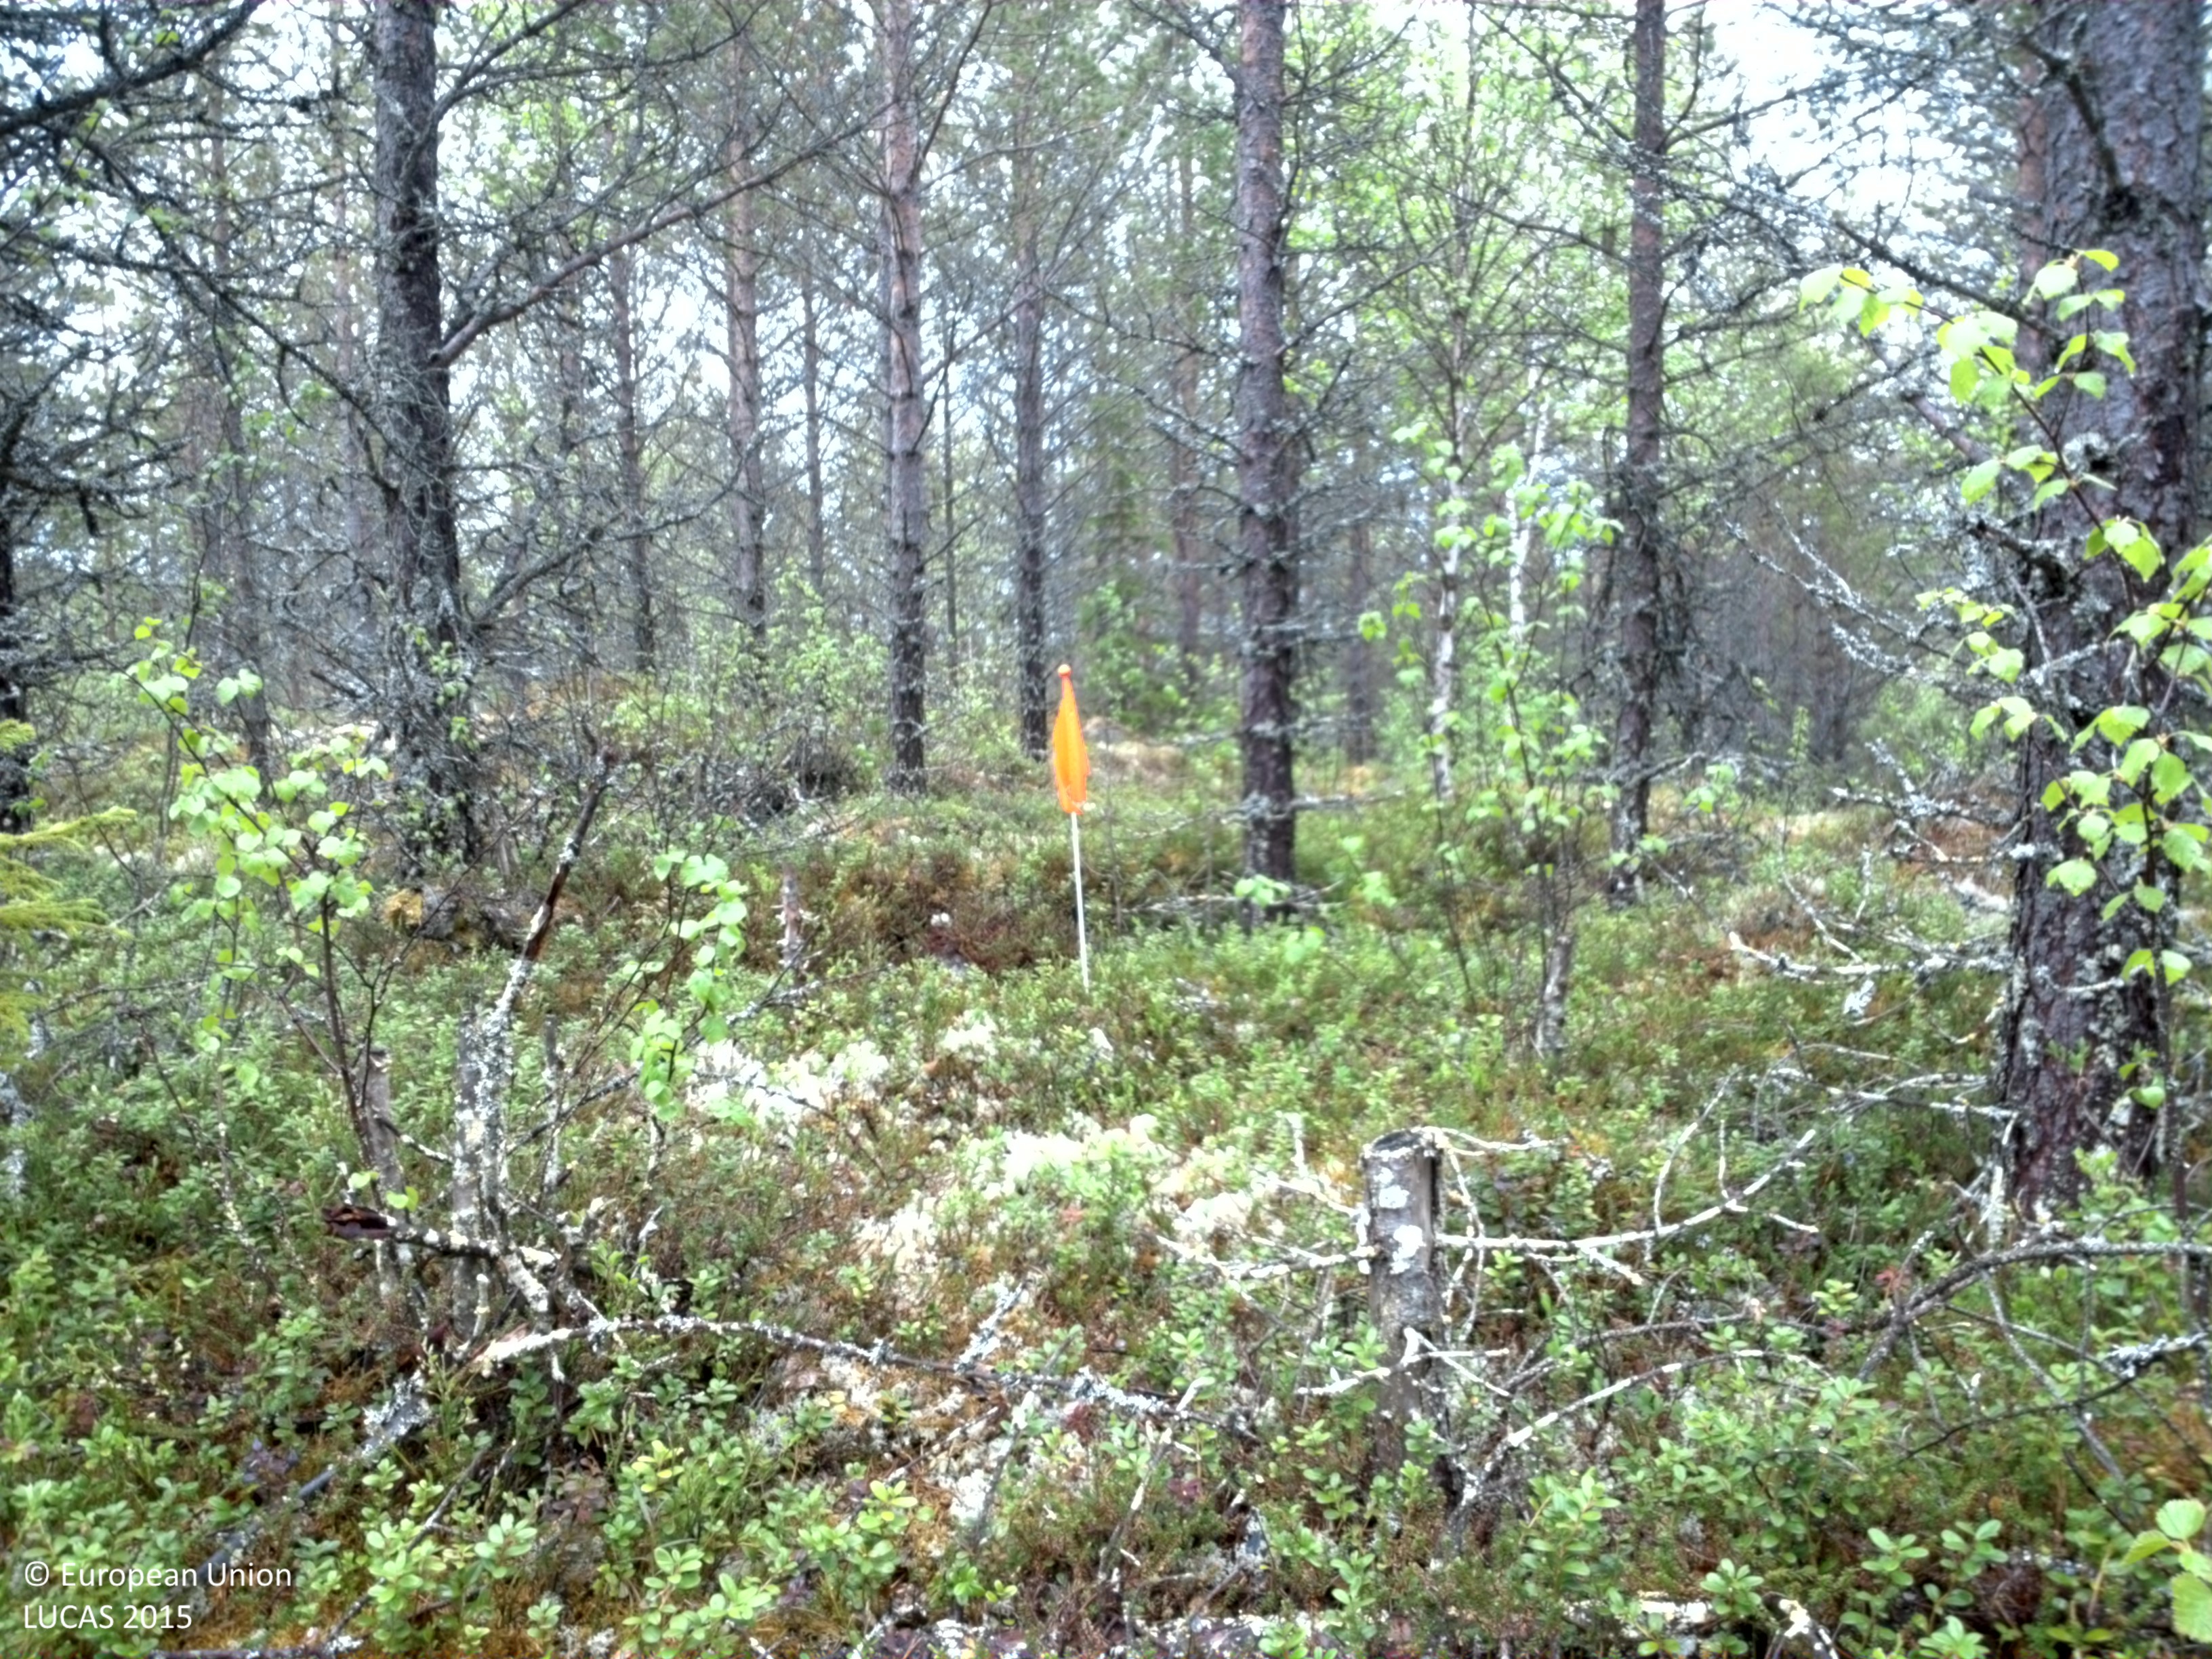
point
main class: Woodland
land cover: Pine dominated mixed woodland
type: boreal forest
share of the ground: 50 - 75 %
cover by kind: coniferous forest trees 40 %, shrubs 35 %, broadleaved forest trees 15 %, lichens and mosses 10 %
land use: Forestry
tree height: > 5 m
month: June
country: SE
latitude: 62.0640
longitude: 13.6018
